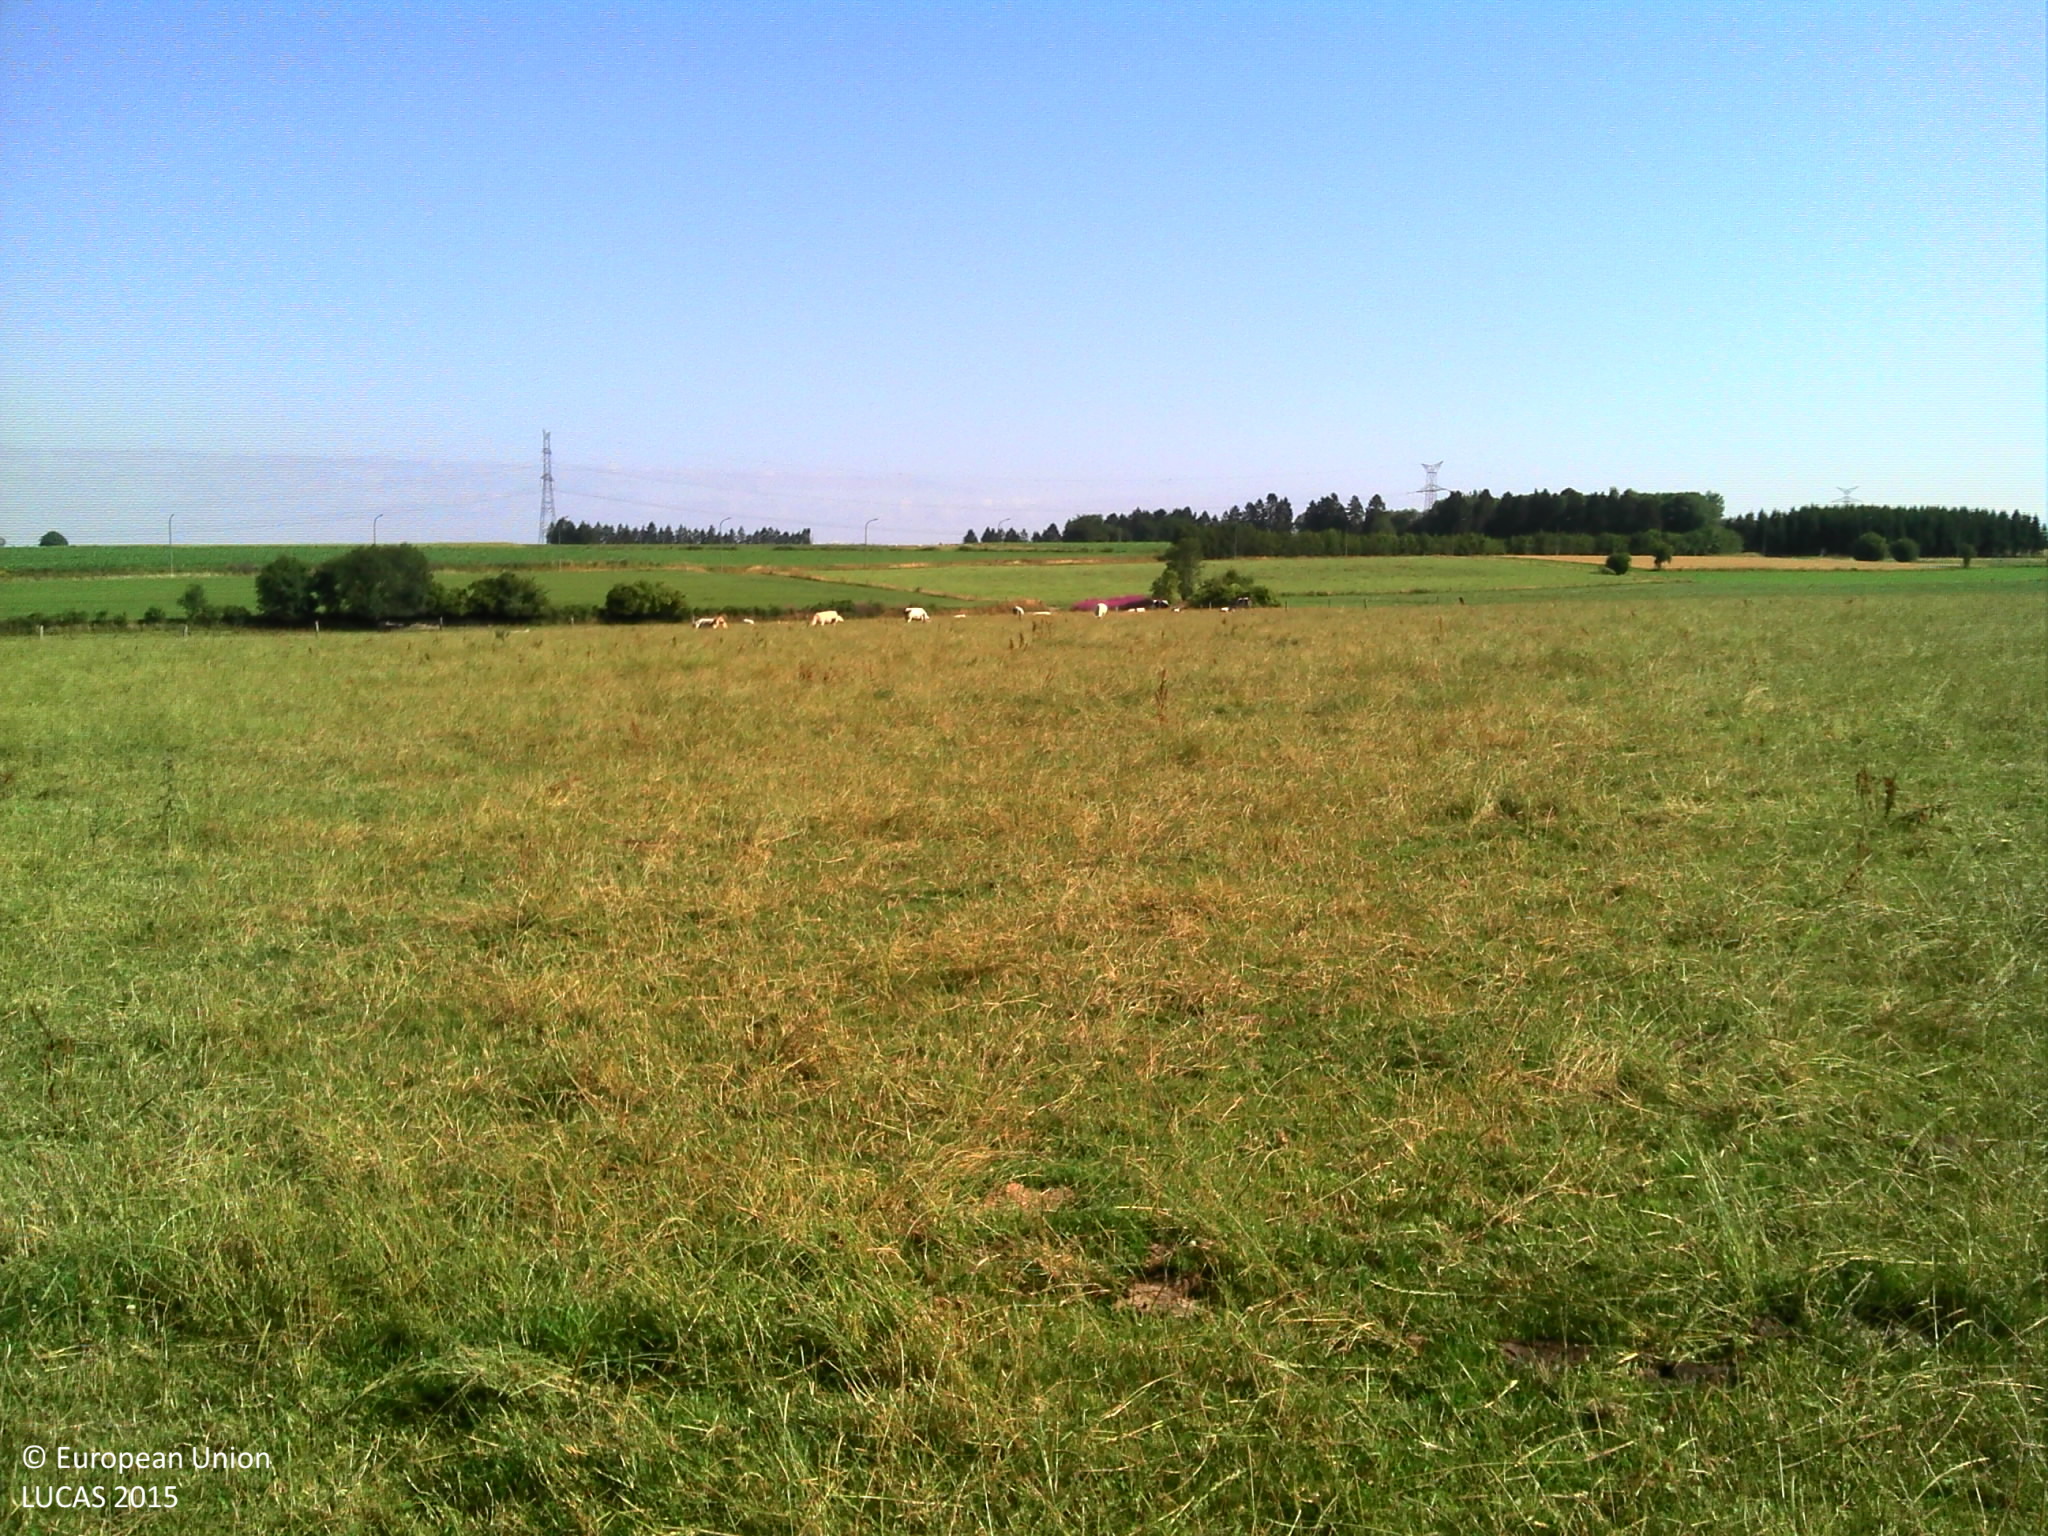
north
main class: Grassland
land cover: Grassland without tree/shrub cover
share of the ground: > 75 %
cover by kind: herbaceous plants 100 %
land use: Agriculture (excluding fallow land and kitchen gardens)
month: July
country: BE
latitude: 50.0137
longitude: 5.7145
